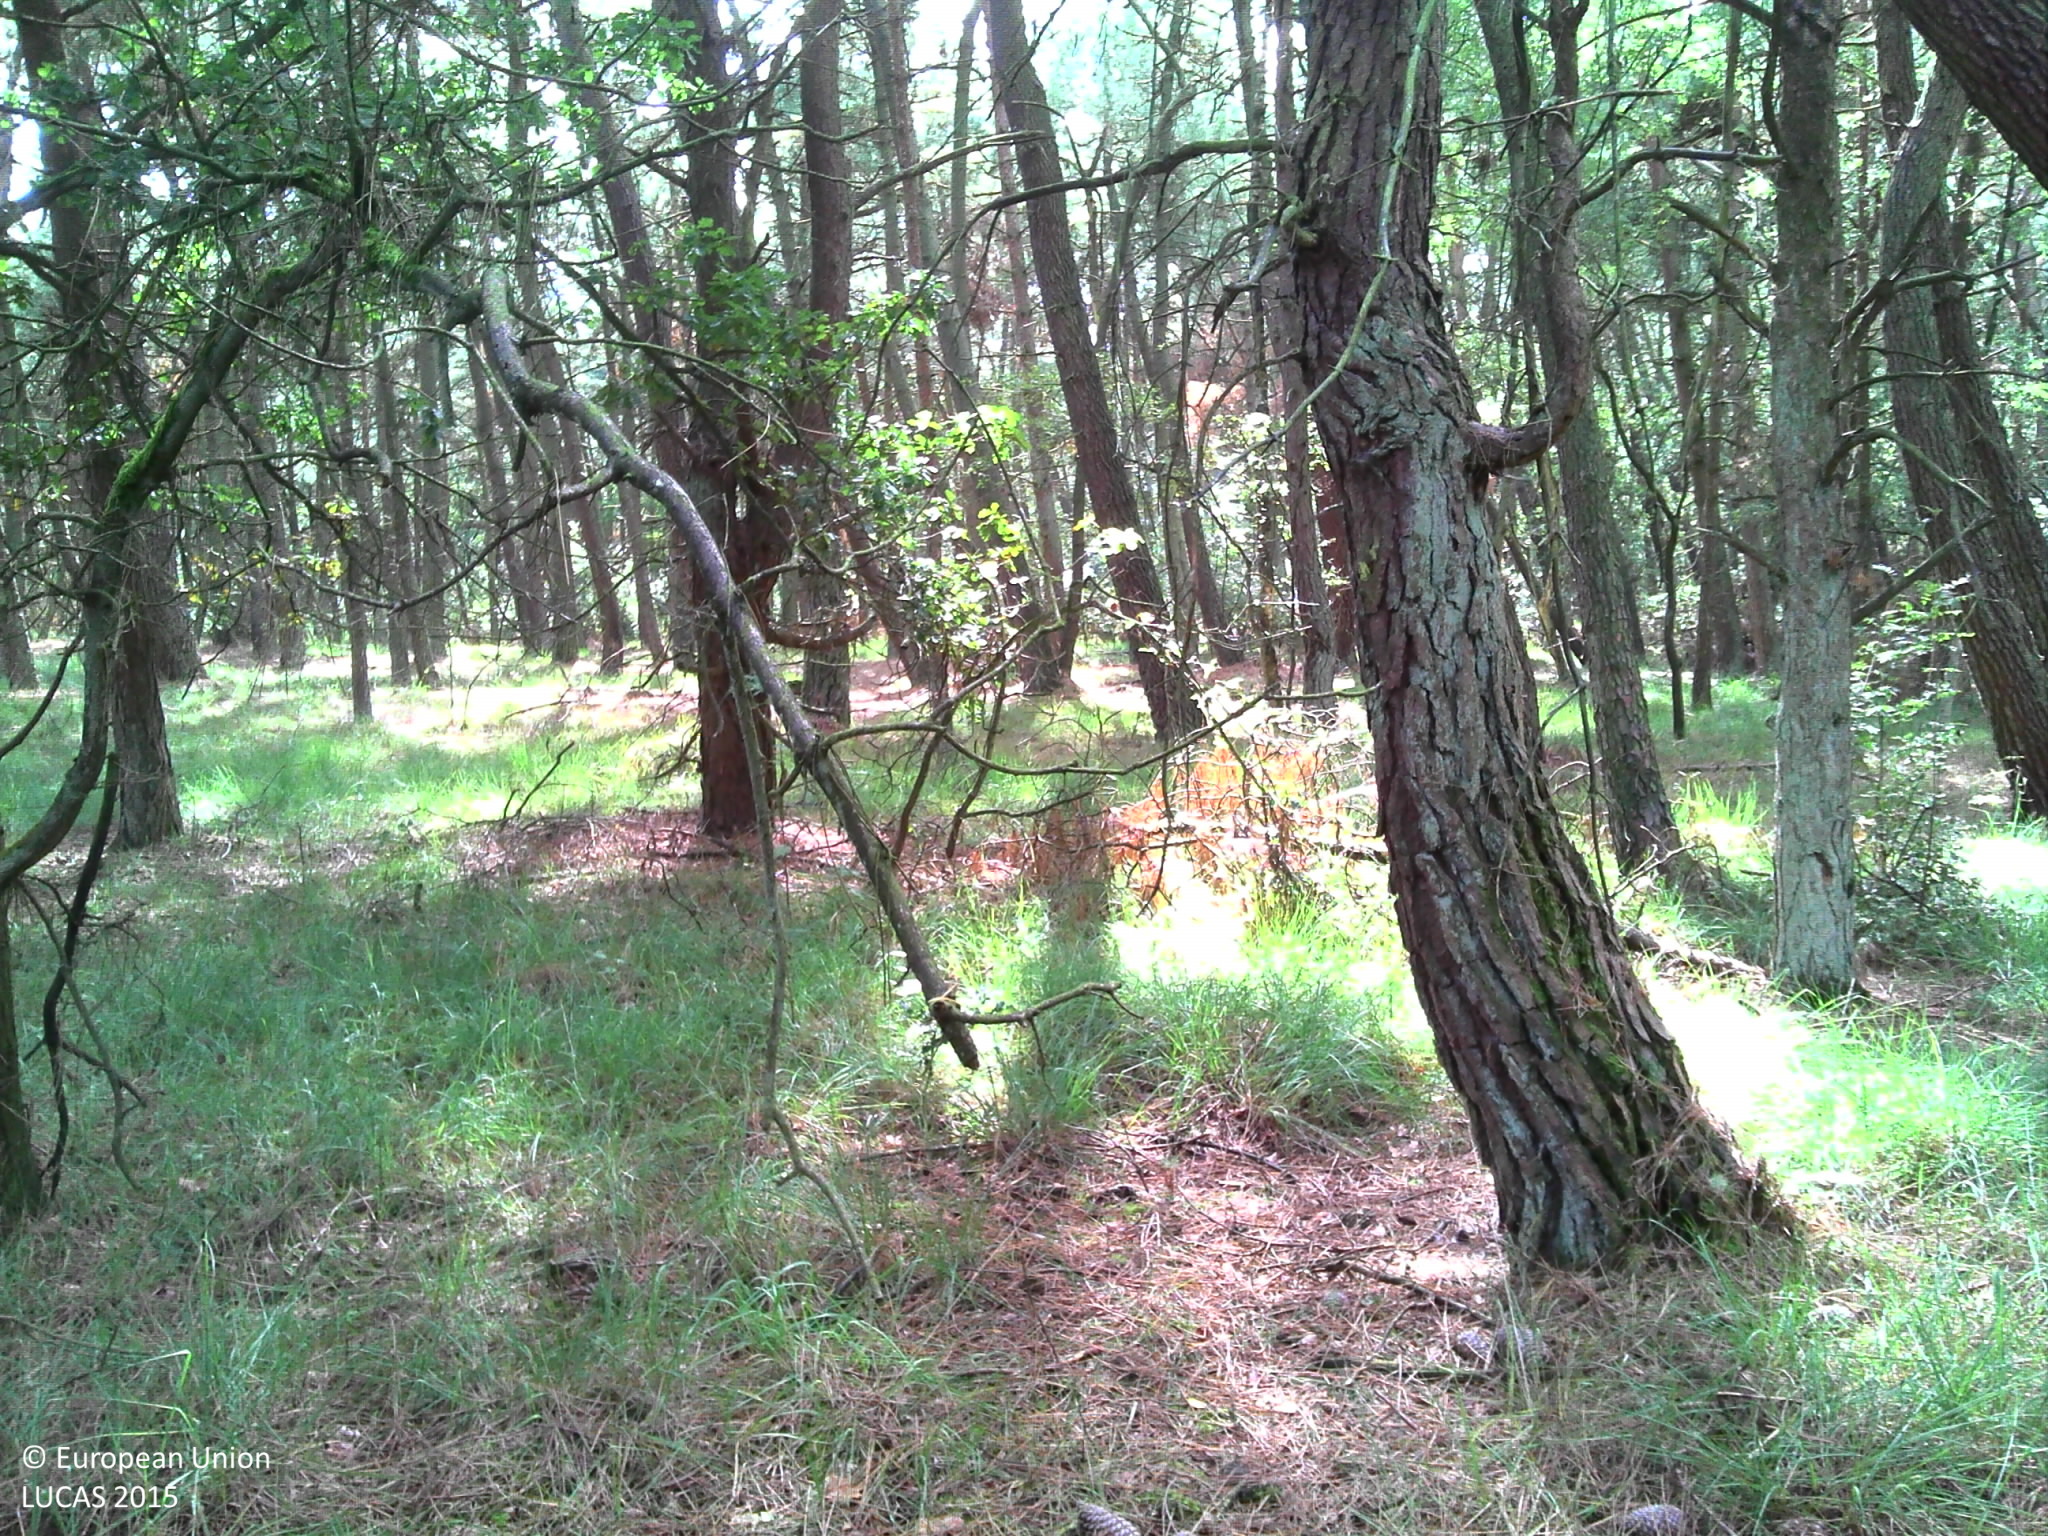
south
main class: Woodland
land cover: Pine dominated coniferous woodland
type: exotic forest
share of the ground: > 75 %
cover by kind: coniferous forest trees 90 %, broadleaved forest trees 5 %, herbaceous plants 5 %
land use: Forestry
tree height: > 5 m
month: September
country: BE
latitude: 51.4165
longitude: 4.4020
